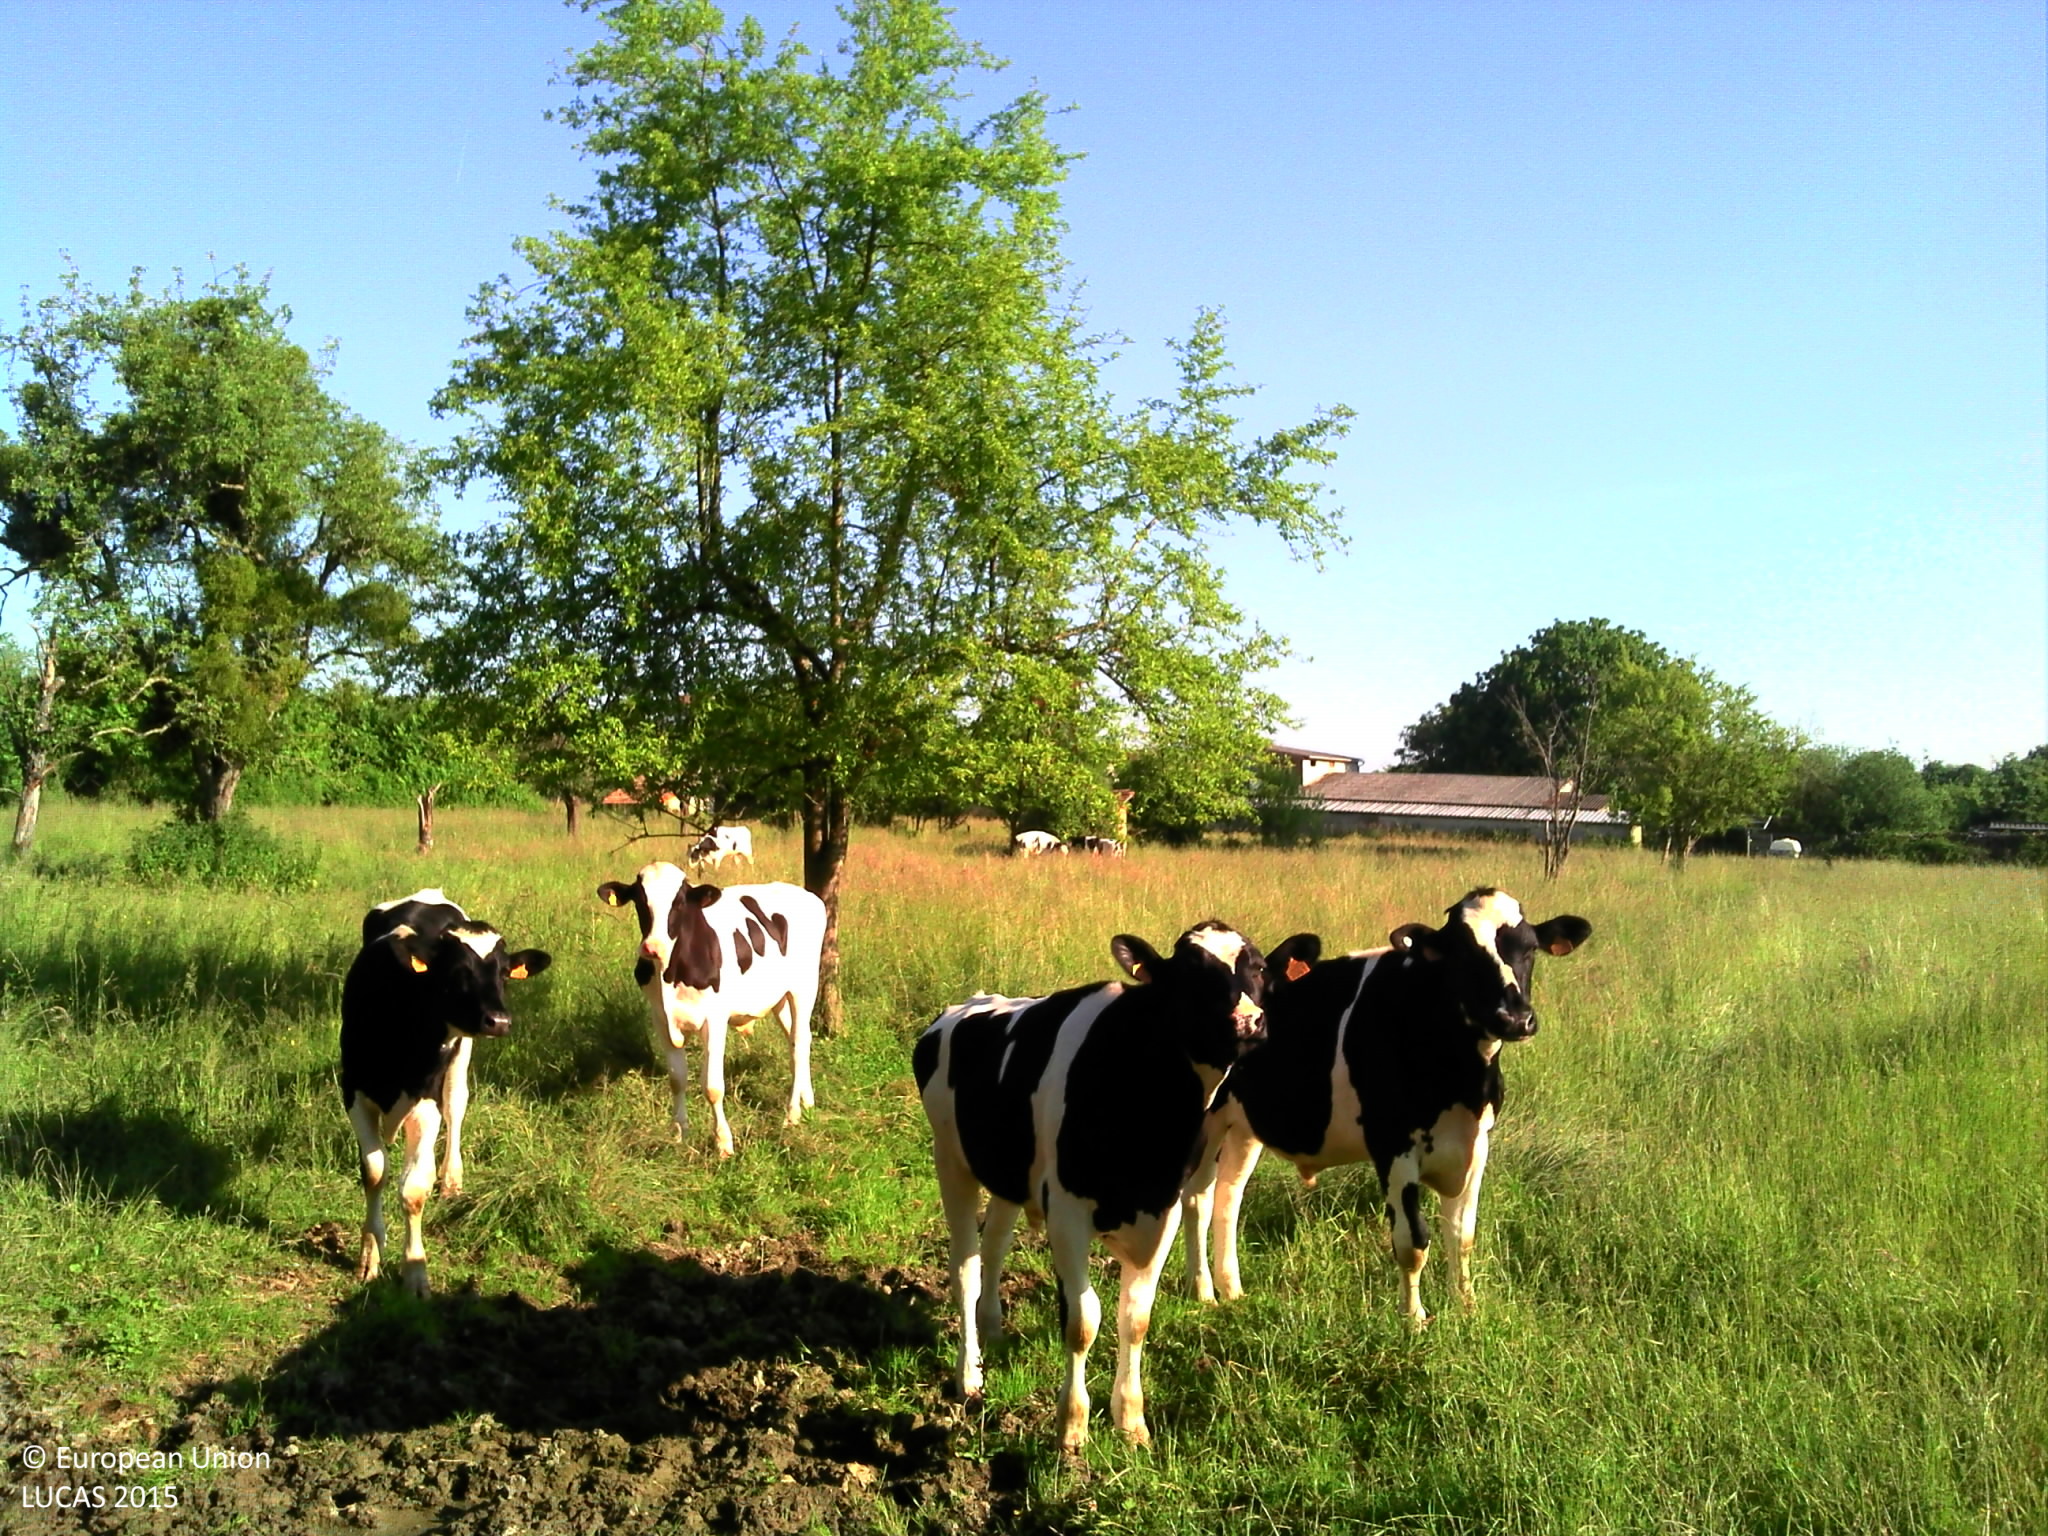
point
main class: Grassland
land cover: Grassland with sparse tree/shrub cover
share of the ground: > 75 %
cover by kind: herbaceous plants 90 %, broadleaved forest trees 5 %, shrubs 5 %
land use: Agriculture (excluding fallow land and kitchen gardens)
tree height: > 5 m
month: June
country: FR
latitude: 48.4560
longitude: 4.6836
